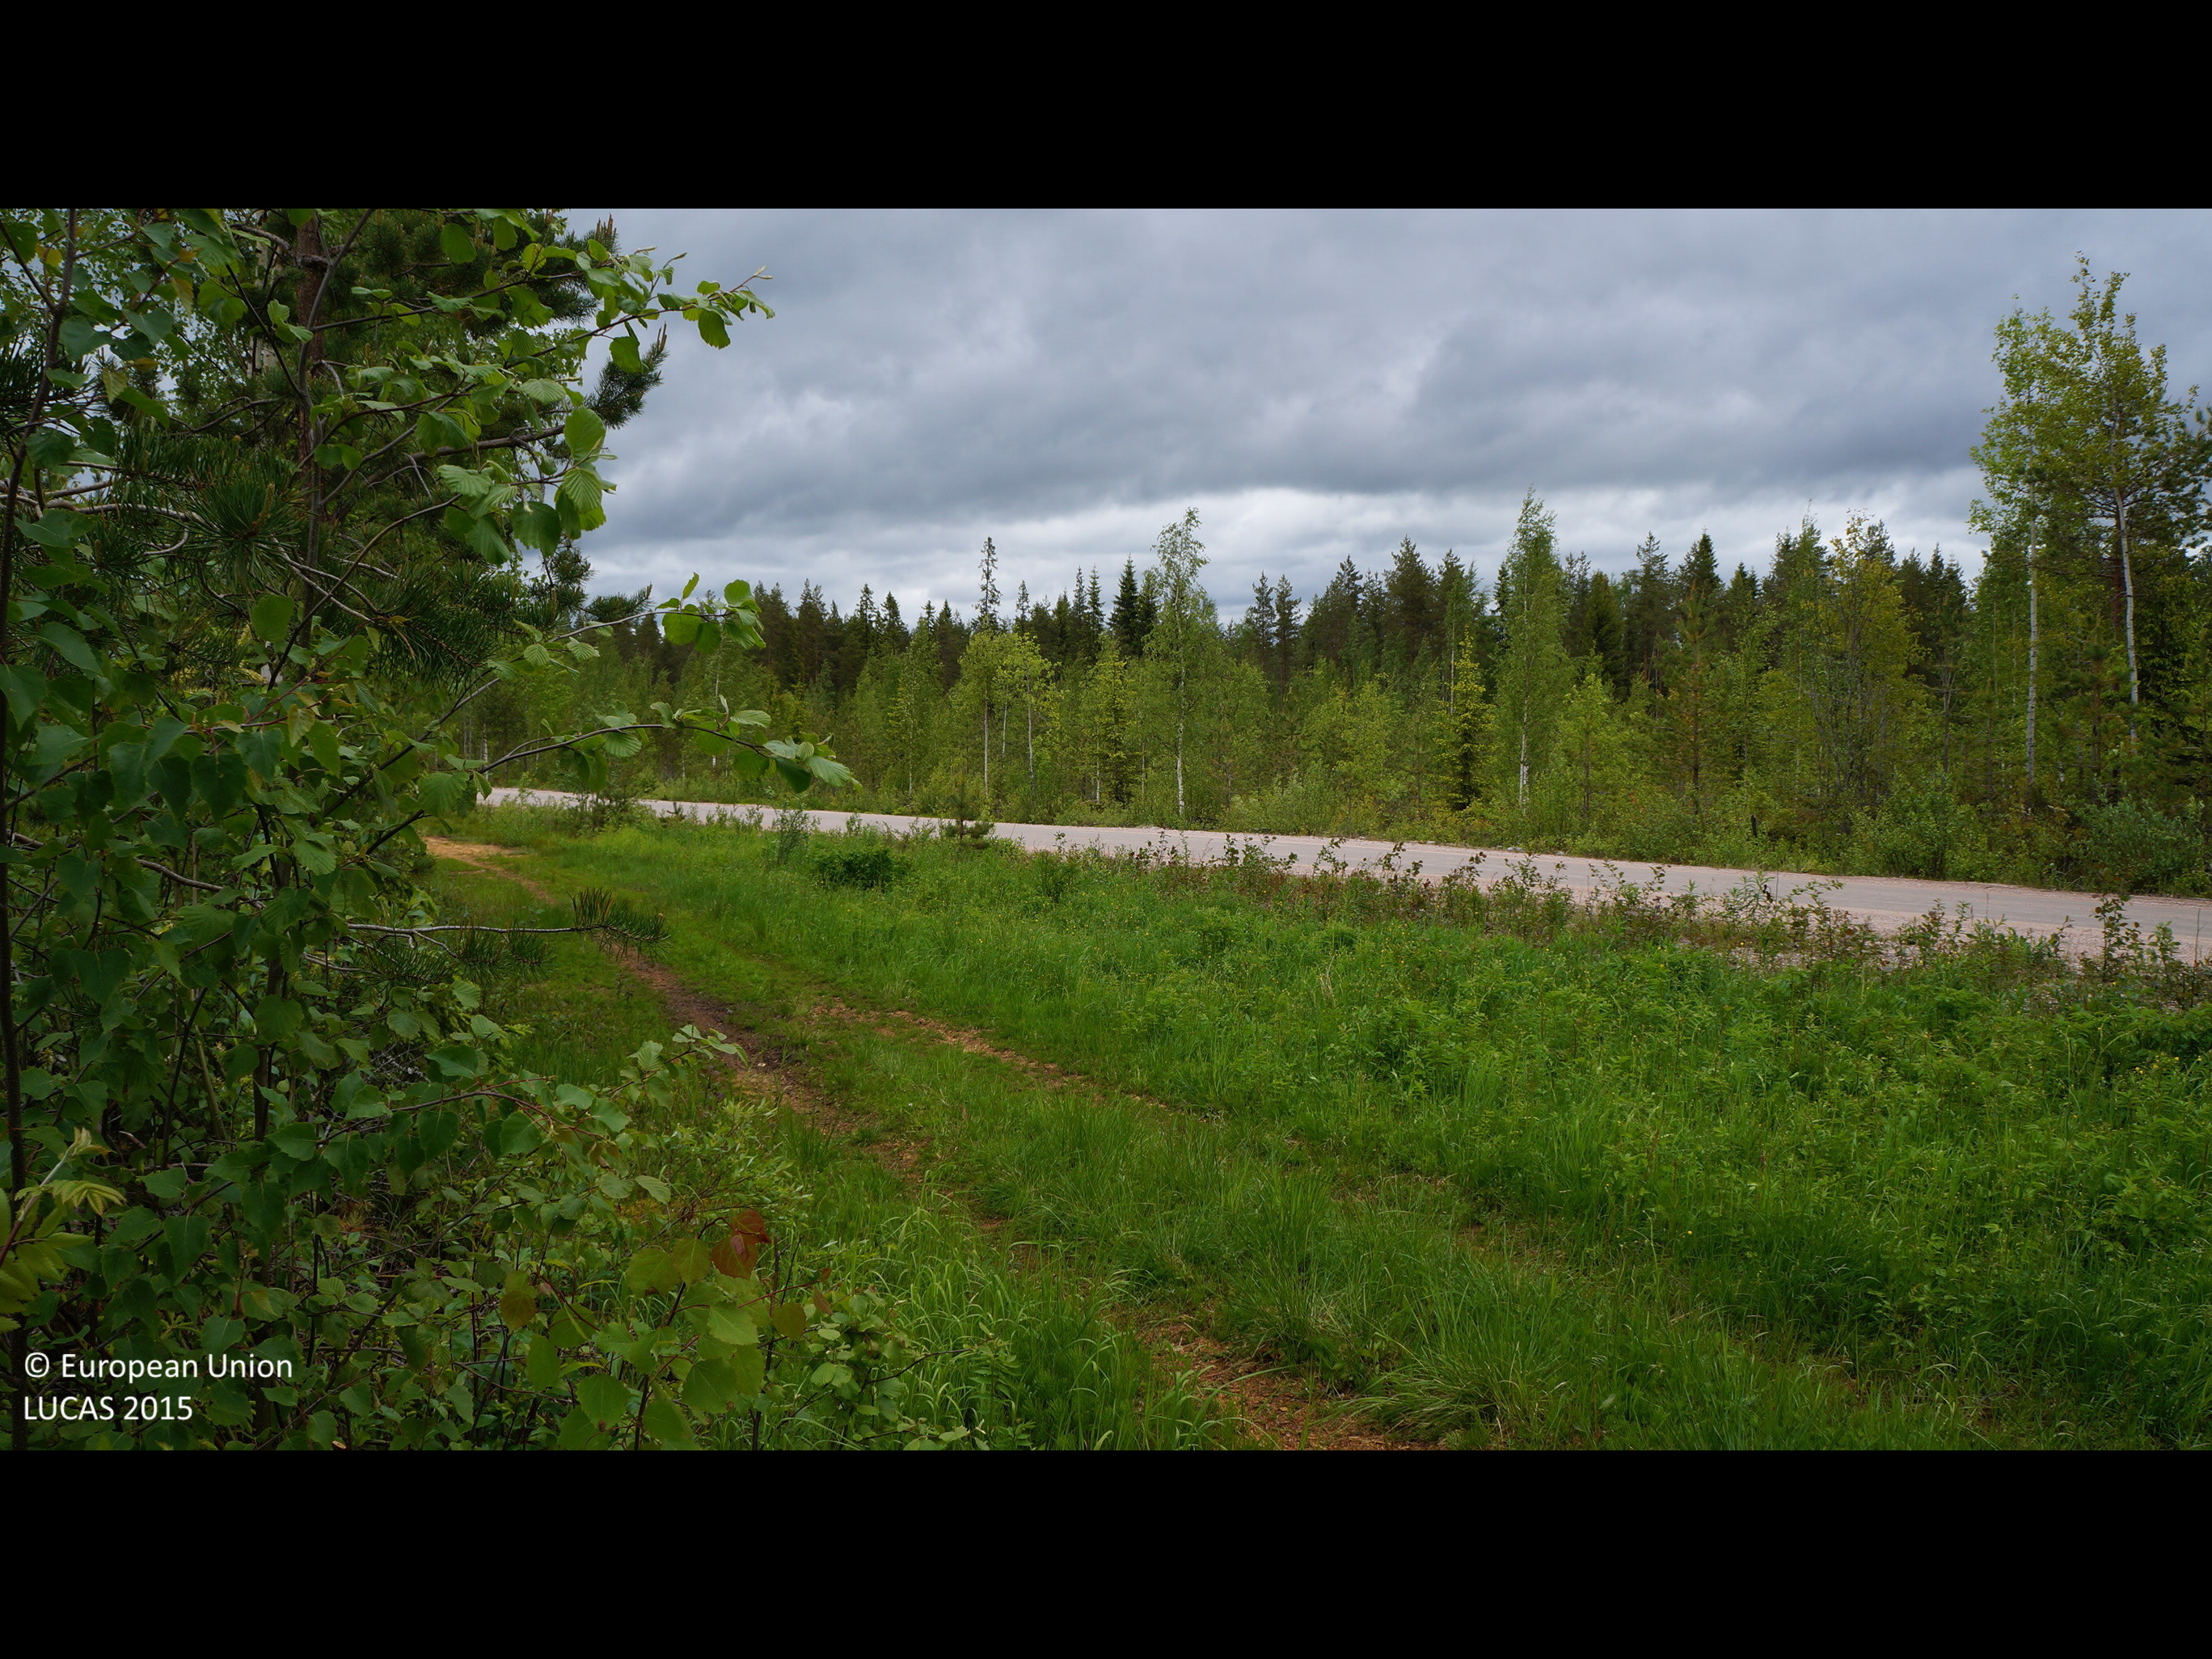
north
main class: Woodland
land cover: Pine dominated mixed woodland
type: boreal forest
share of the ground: 25 - 50 %
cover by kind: shrubs 35 %, broadleaved forest trees 25 %, coniferous forest trees 20 %, herbaceous plants 10 %, lichens and mosses 10 %
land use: Forestry
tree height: > 5 m
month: June
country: FI
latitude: 63.8929
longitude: 24.8912
